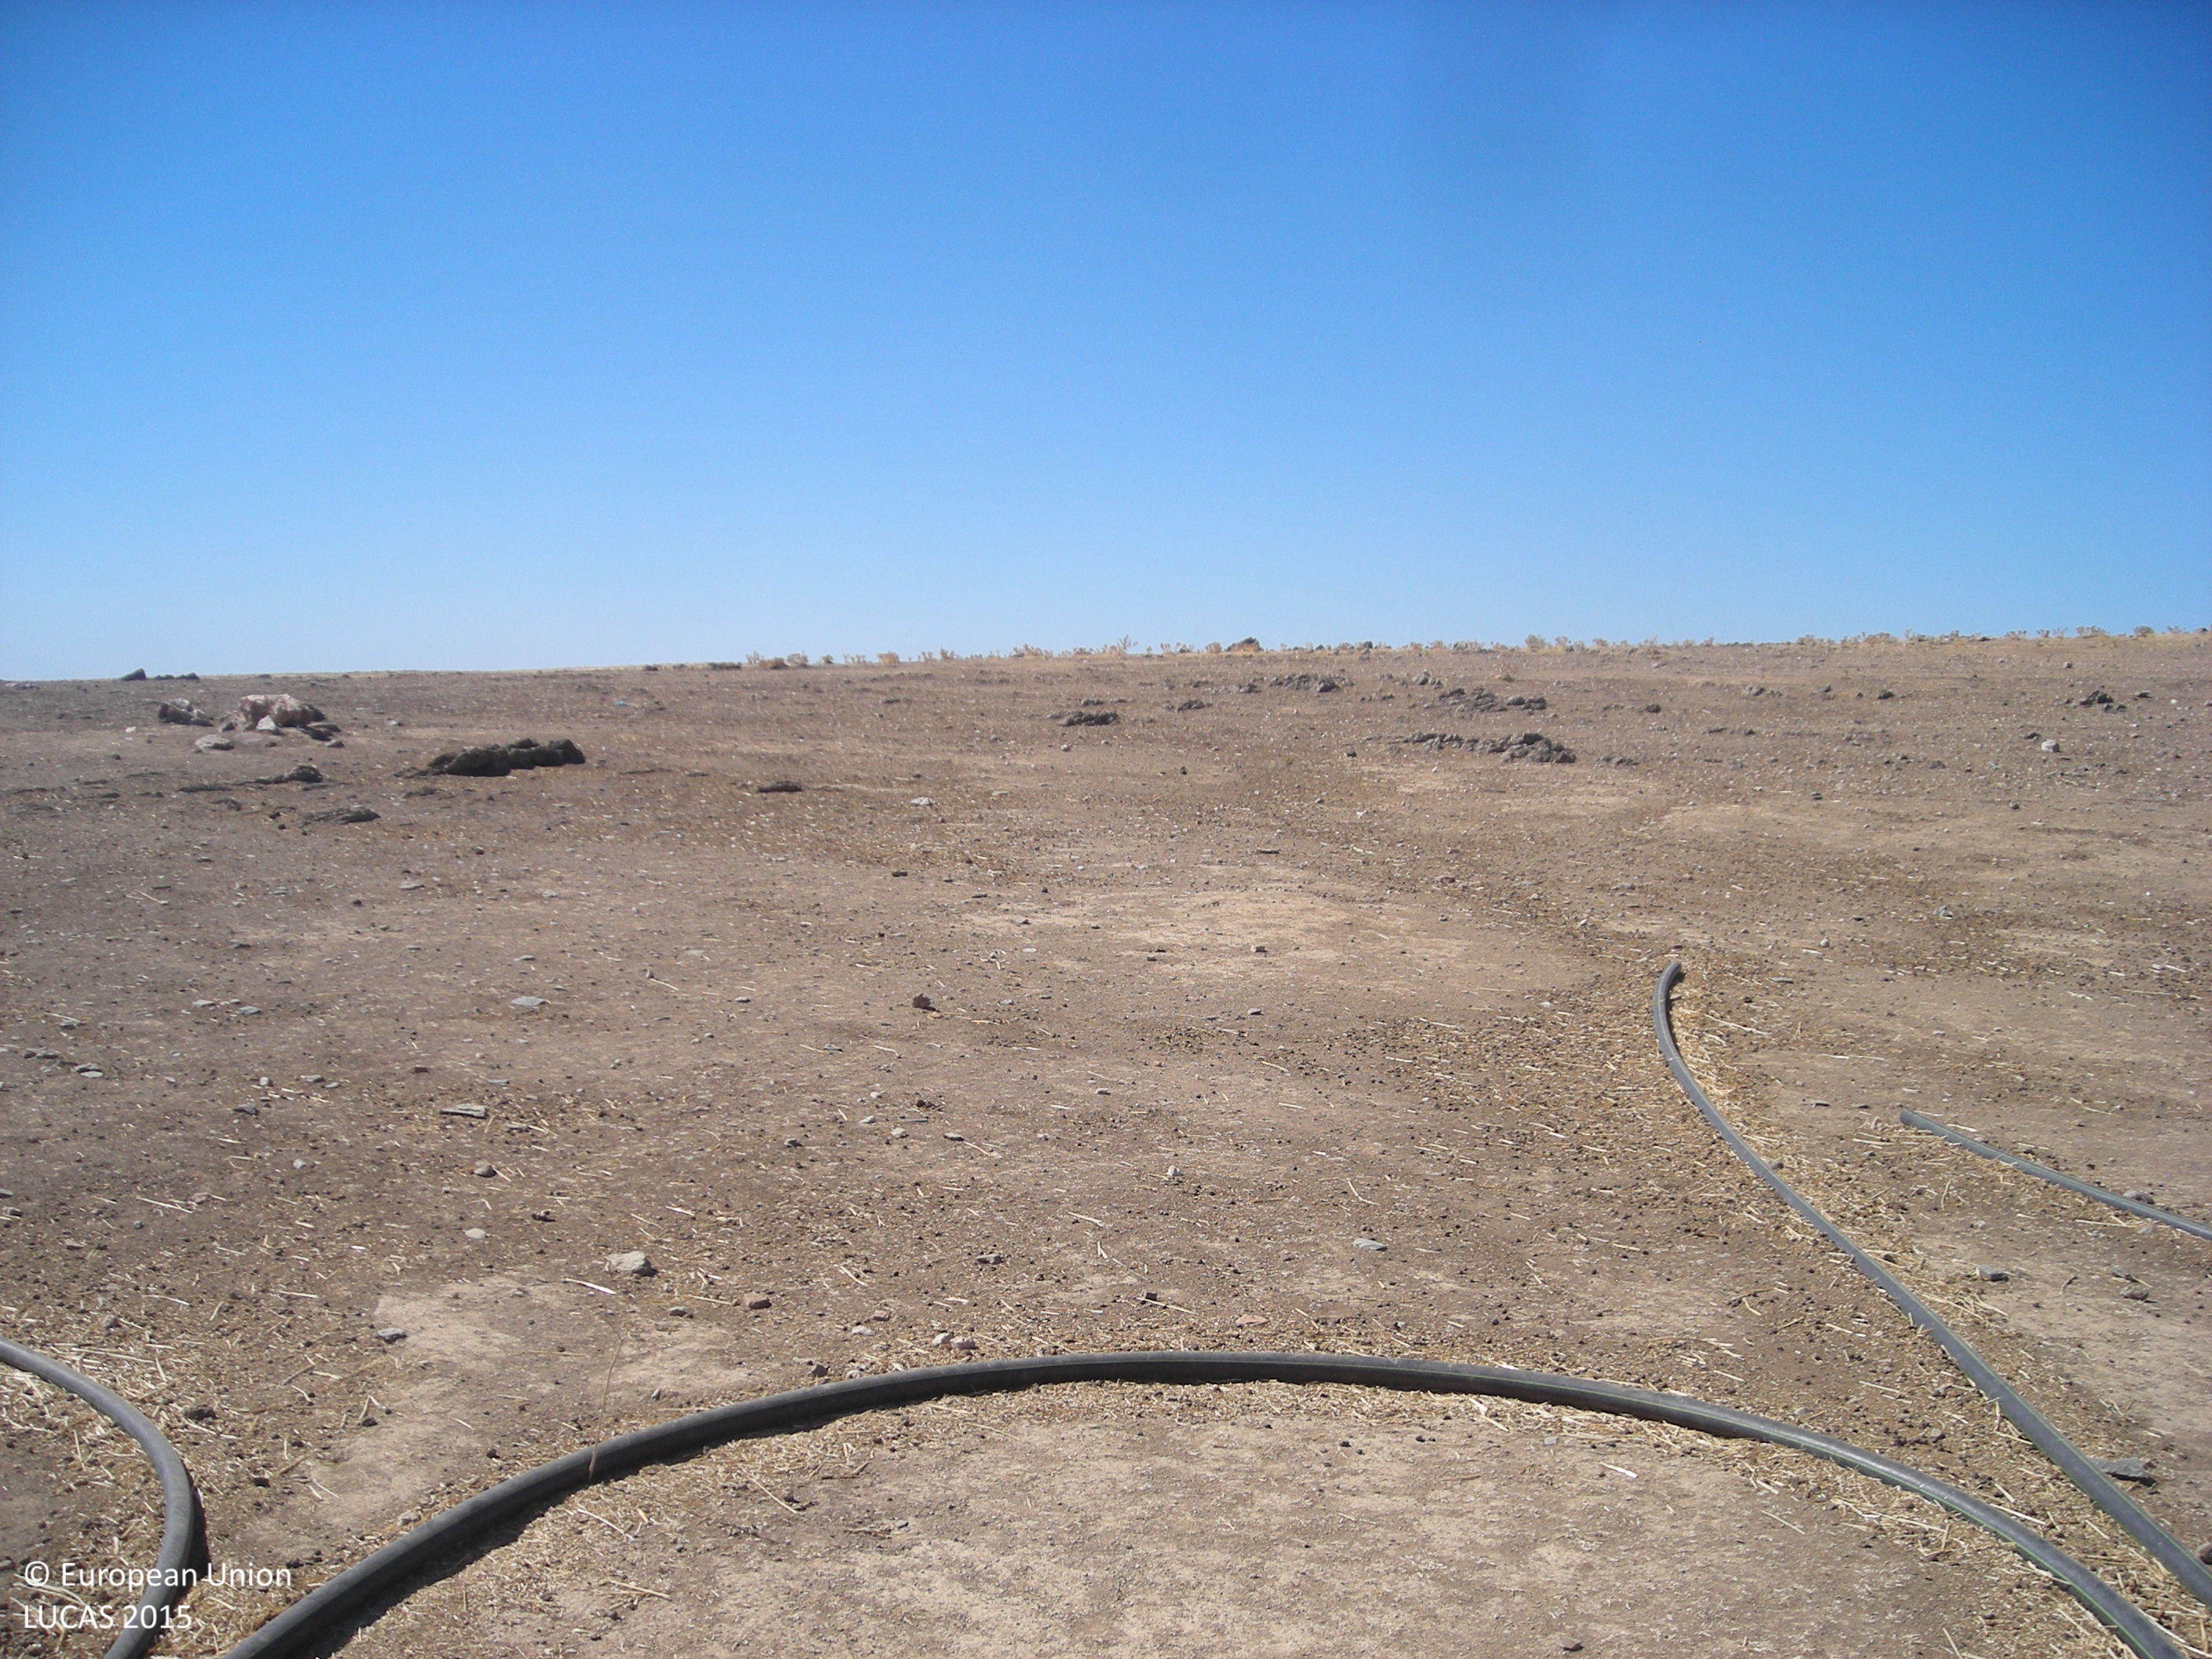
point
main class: Grassland
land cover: Grassland without tree/shrub cover
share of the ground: > 75 %
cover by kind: herbaceous plants 100 %
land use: Agriculture (excluding fallow land and kitchen gardens)
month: July
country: ES
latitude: 38.7315
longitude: -5.3945
